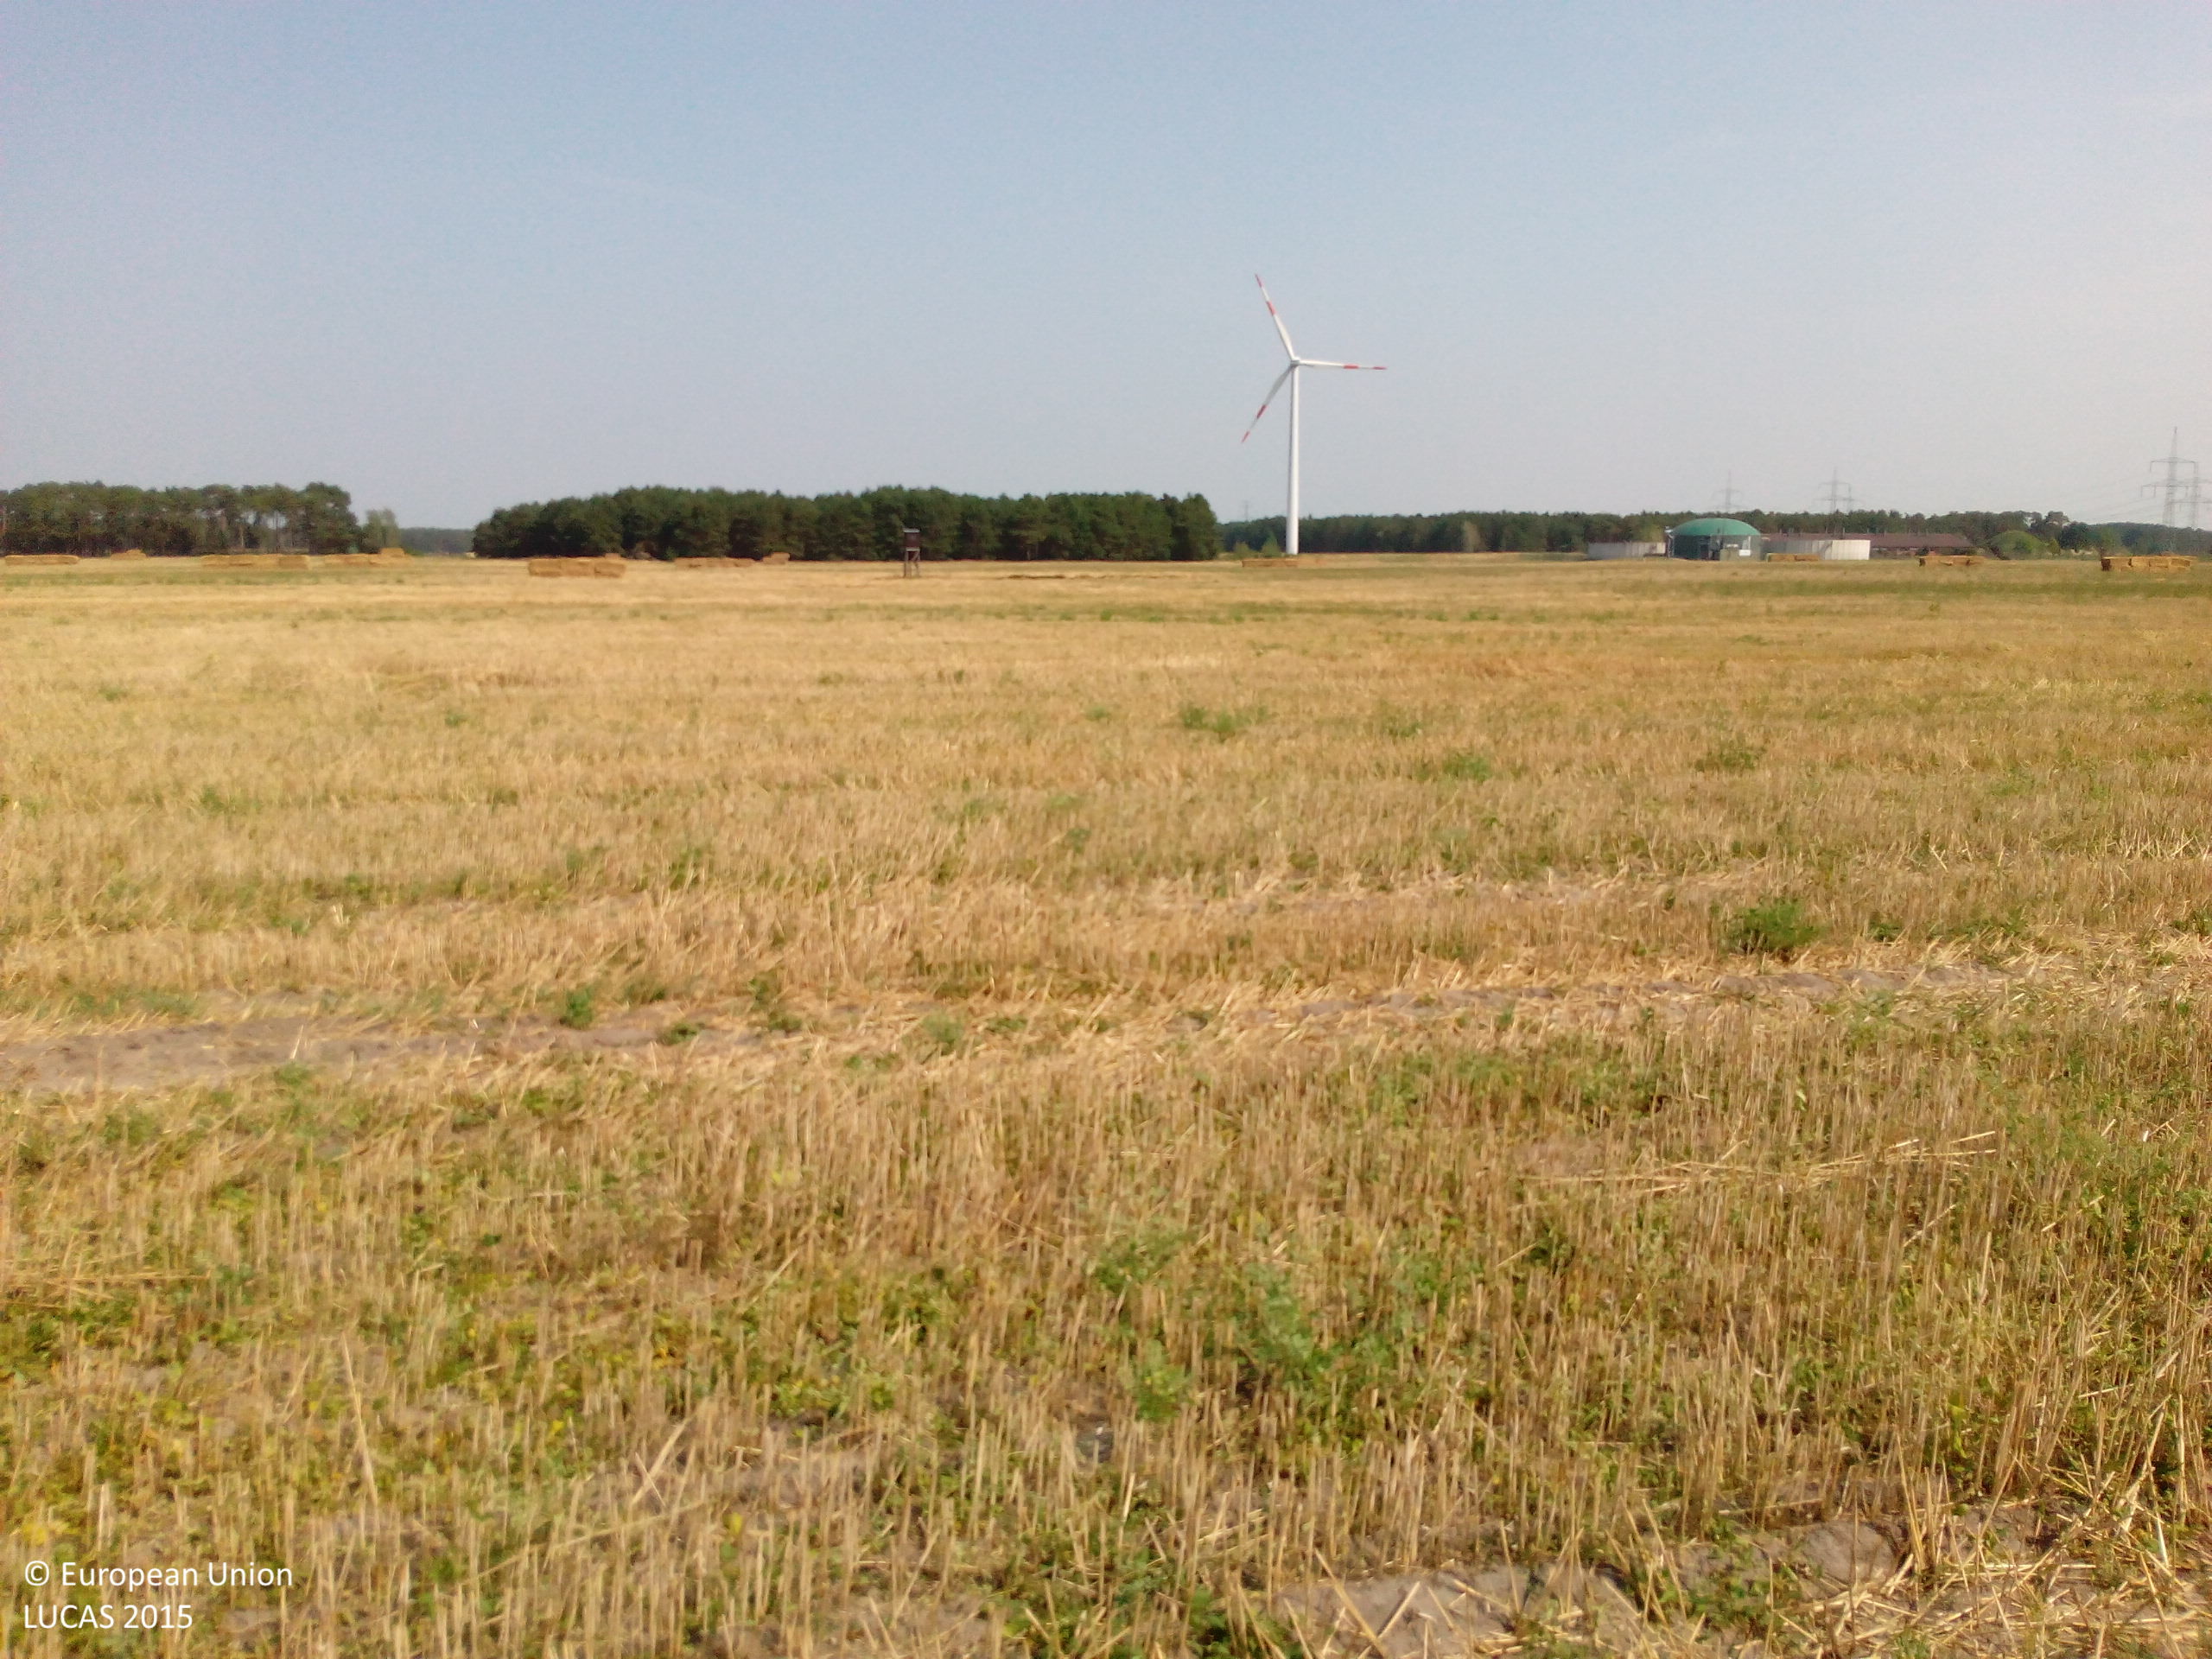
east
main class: Cropland
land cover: Rye
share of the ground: 10 - 25 %
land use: Agriculture (excluding fallow land and kitchen gardens)
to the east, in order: Rye; Grass margins; Ditches and canals; Grass margins; Rye
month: August
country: DE
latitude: 51.8829
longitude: 14.3744
